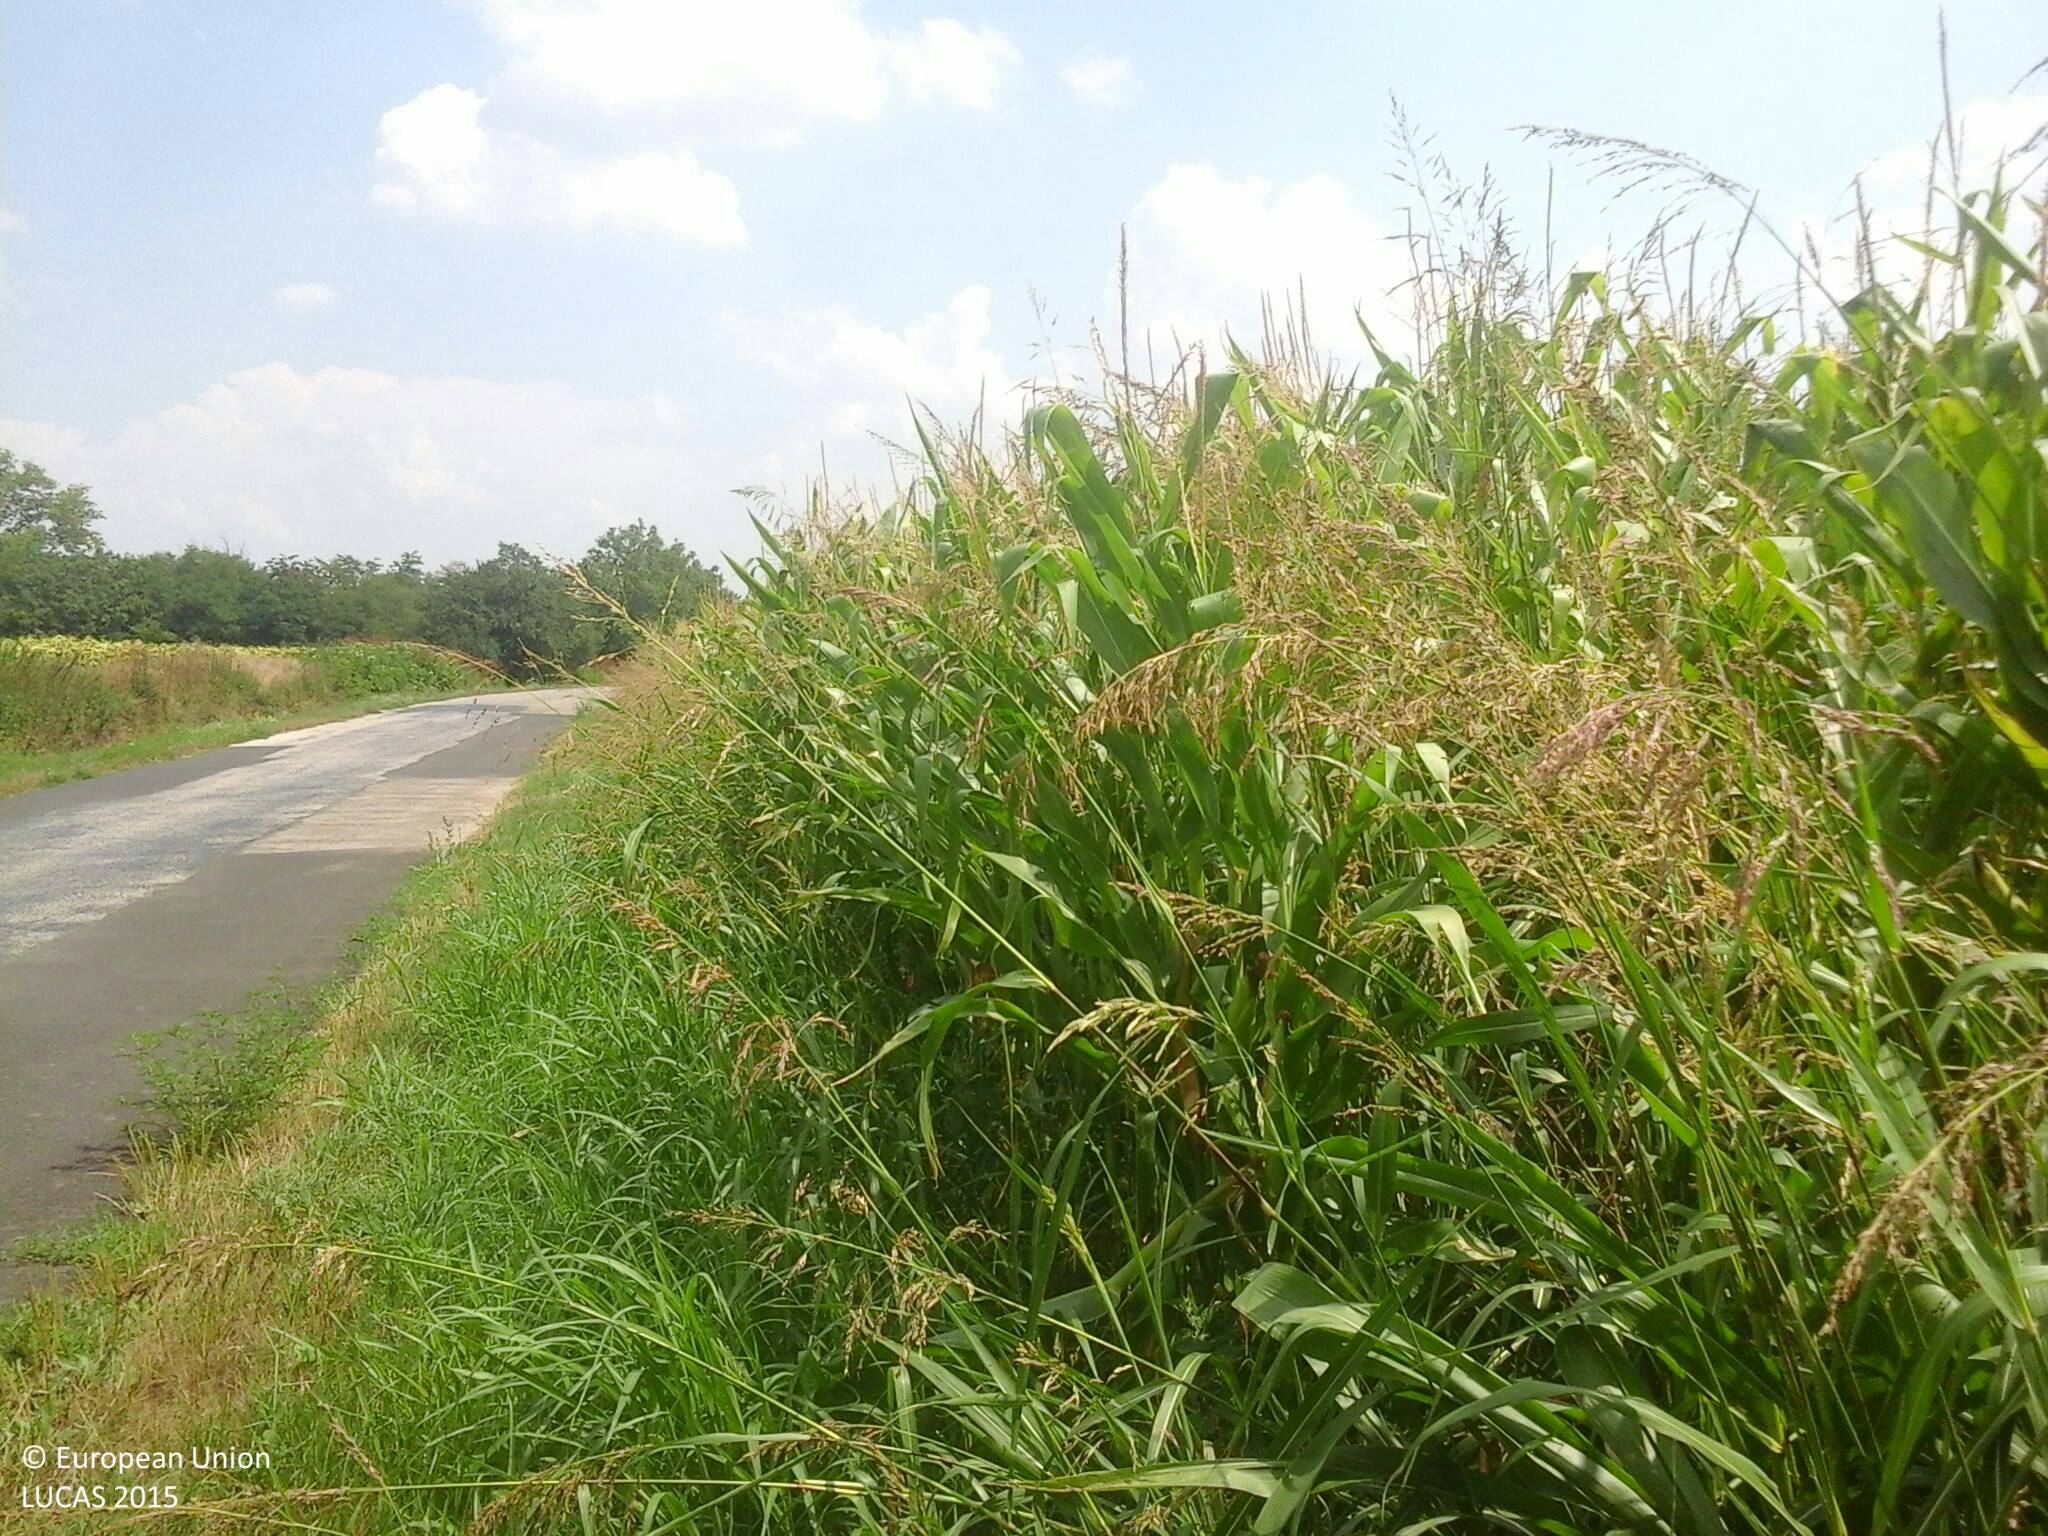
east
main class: Cropland
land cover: Maize
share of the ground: > 75 %
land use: Agriculture (excluding fallow land and kitchen gardens)
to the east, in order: Maize
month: August
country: HU
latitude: 45.9675
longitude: 18.1493
